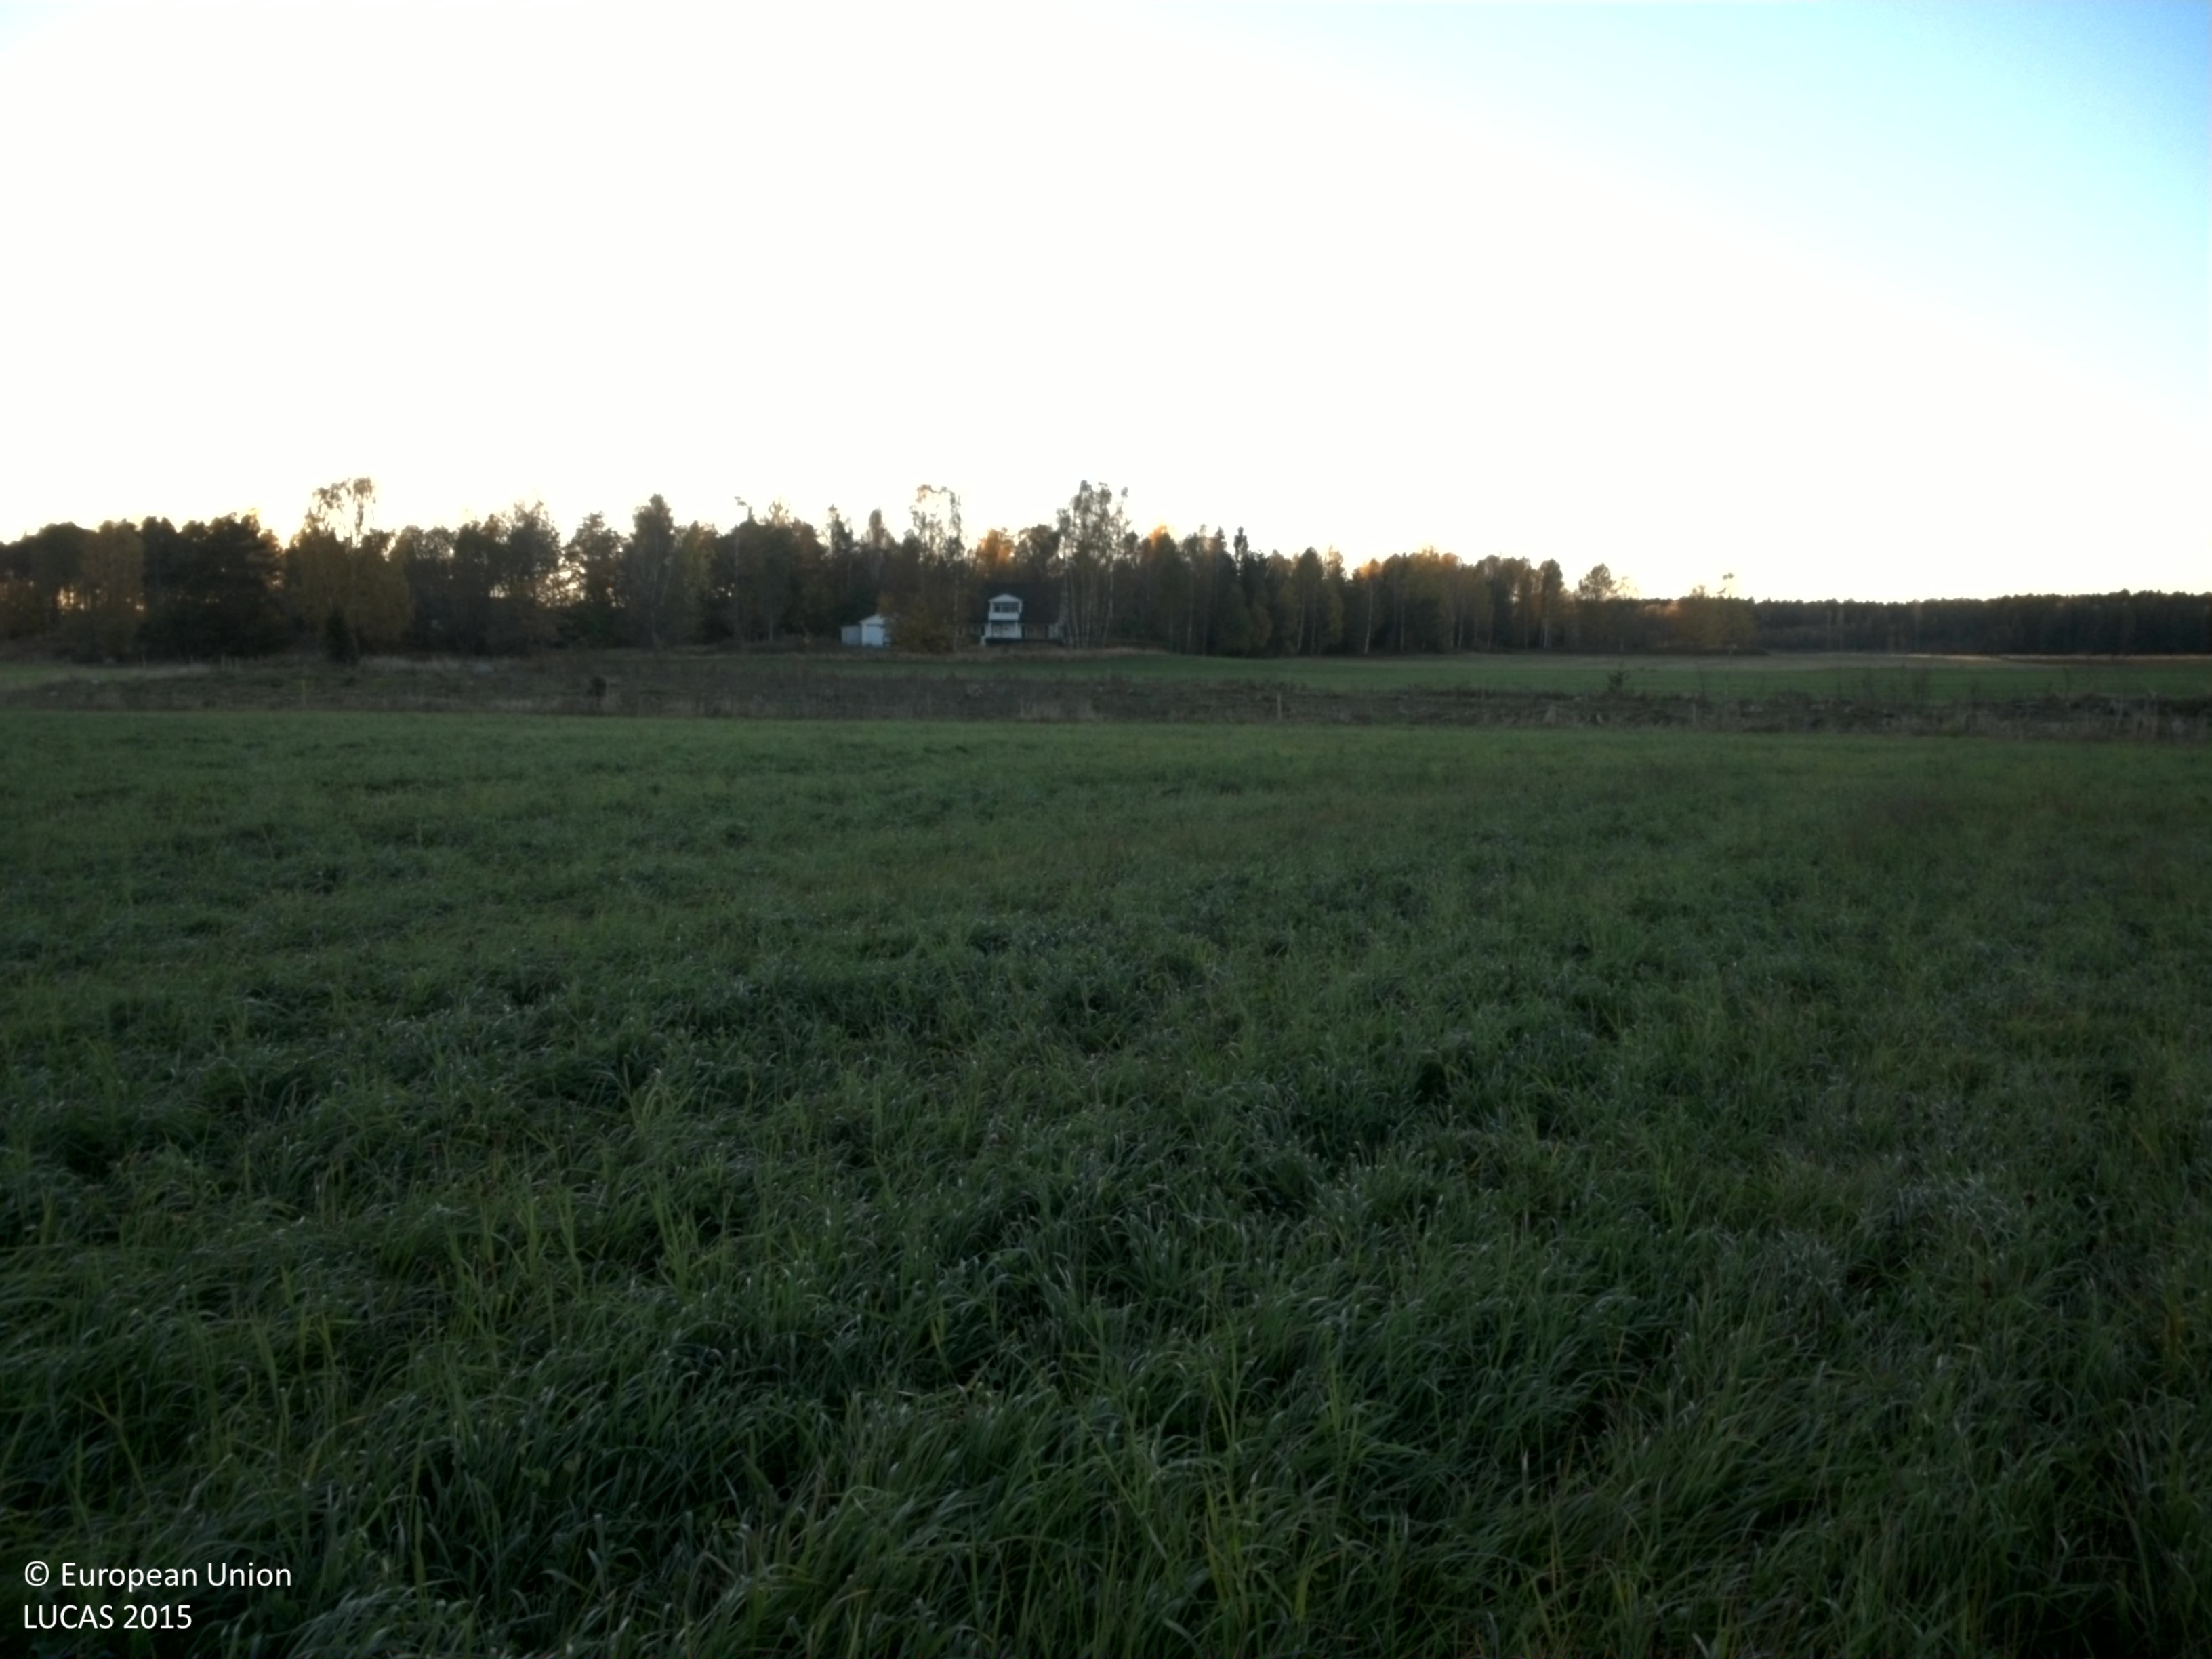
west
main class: Grassland
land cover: Grassland without tree/shrub cover
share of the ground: > 75 %
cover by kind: herbaceous plants 100 %
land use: Agriculture (excluding fallow land and kitchen gardens)
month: October
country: SE
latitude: 59.1555
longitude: 13.1232
